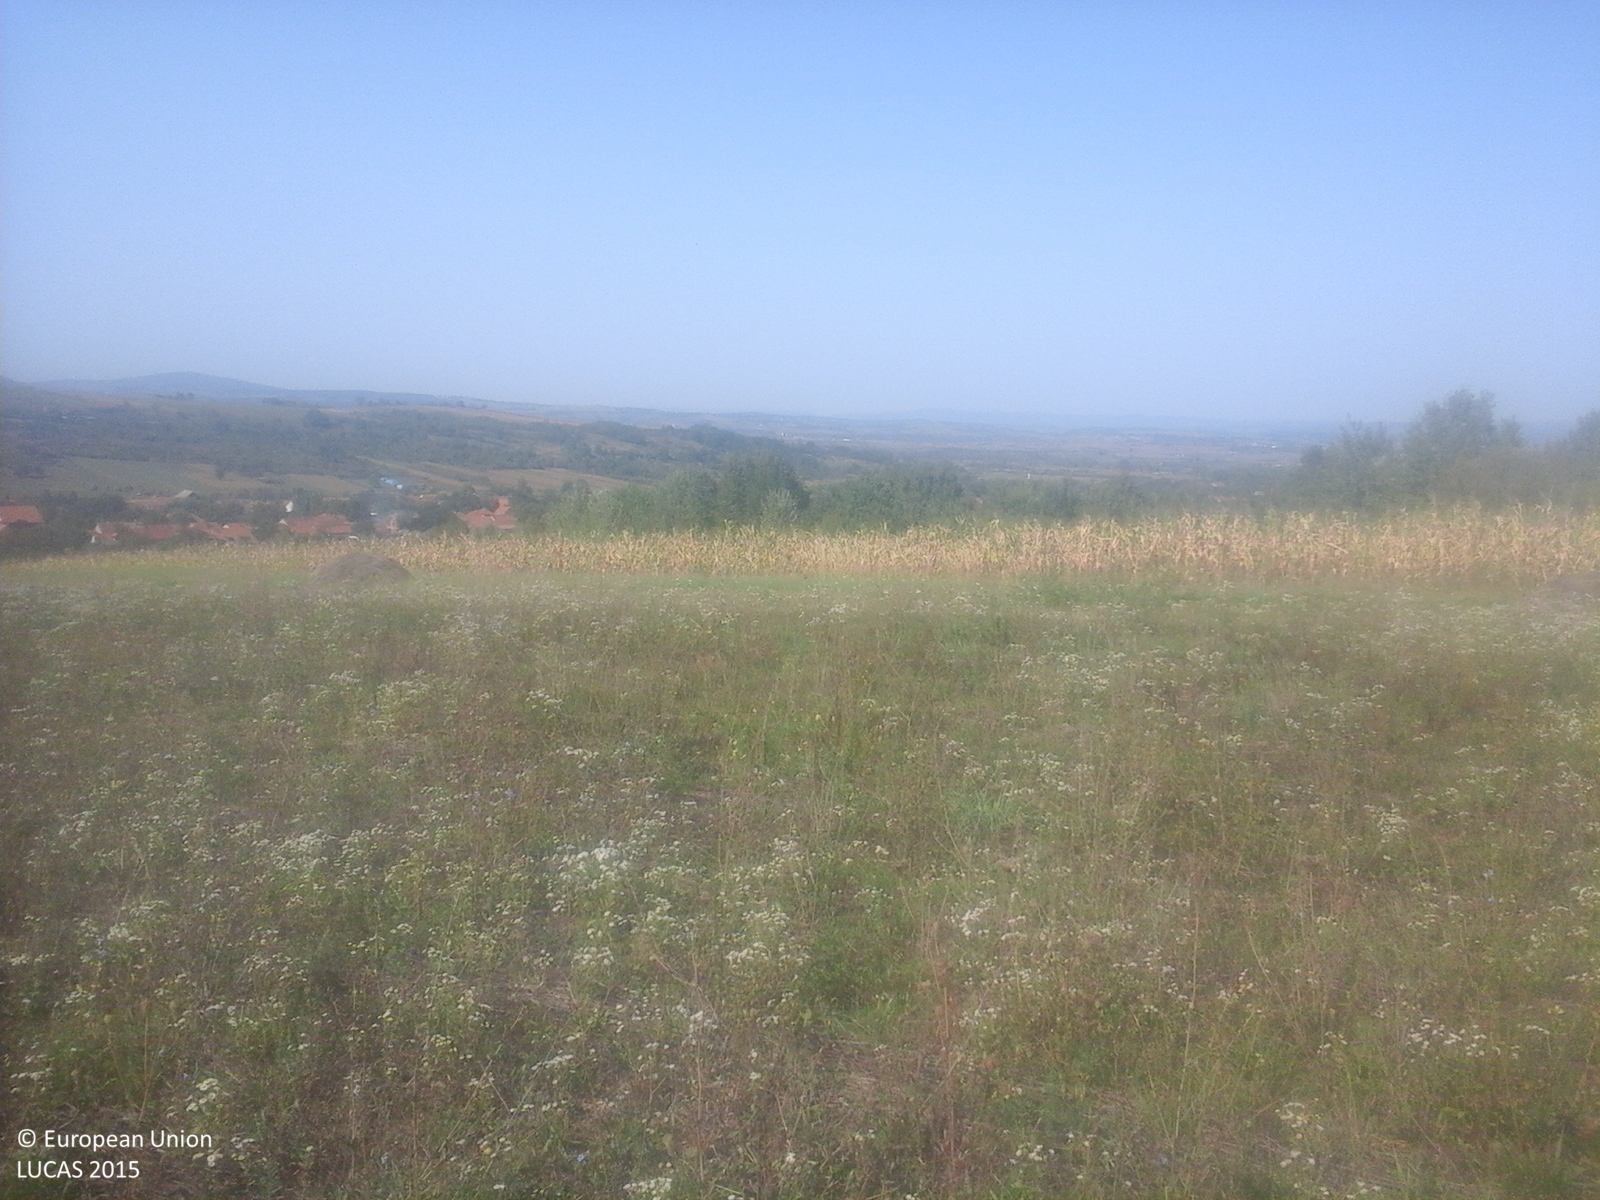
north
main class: Grassland
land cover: Grassland without tree/shrub cover
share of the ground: > 75 %
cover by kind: herbaceous plants 100 %
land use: Agriculture (excluding fallow land and kitchen gardens)
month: September
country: RO
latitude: 46.6379
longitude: 22.3160
